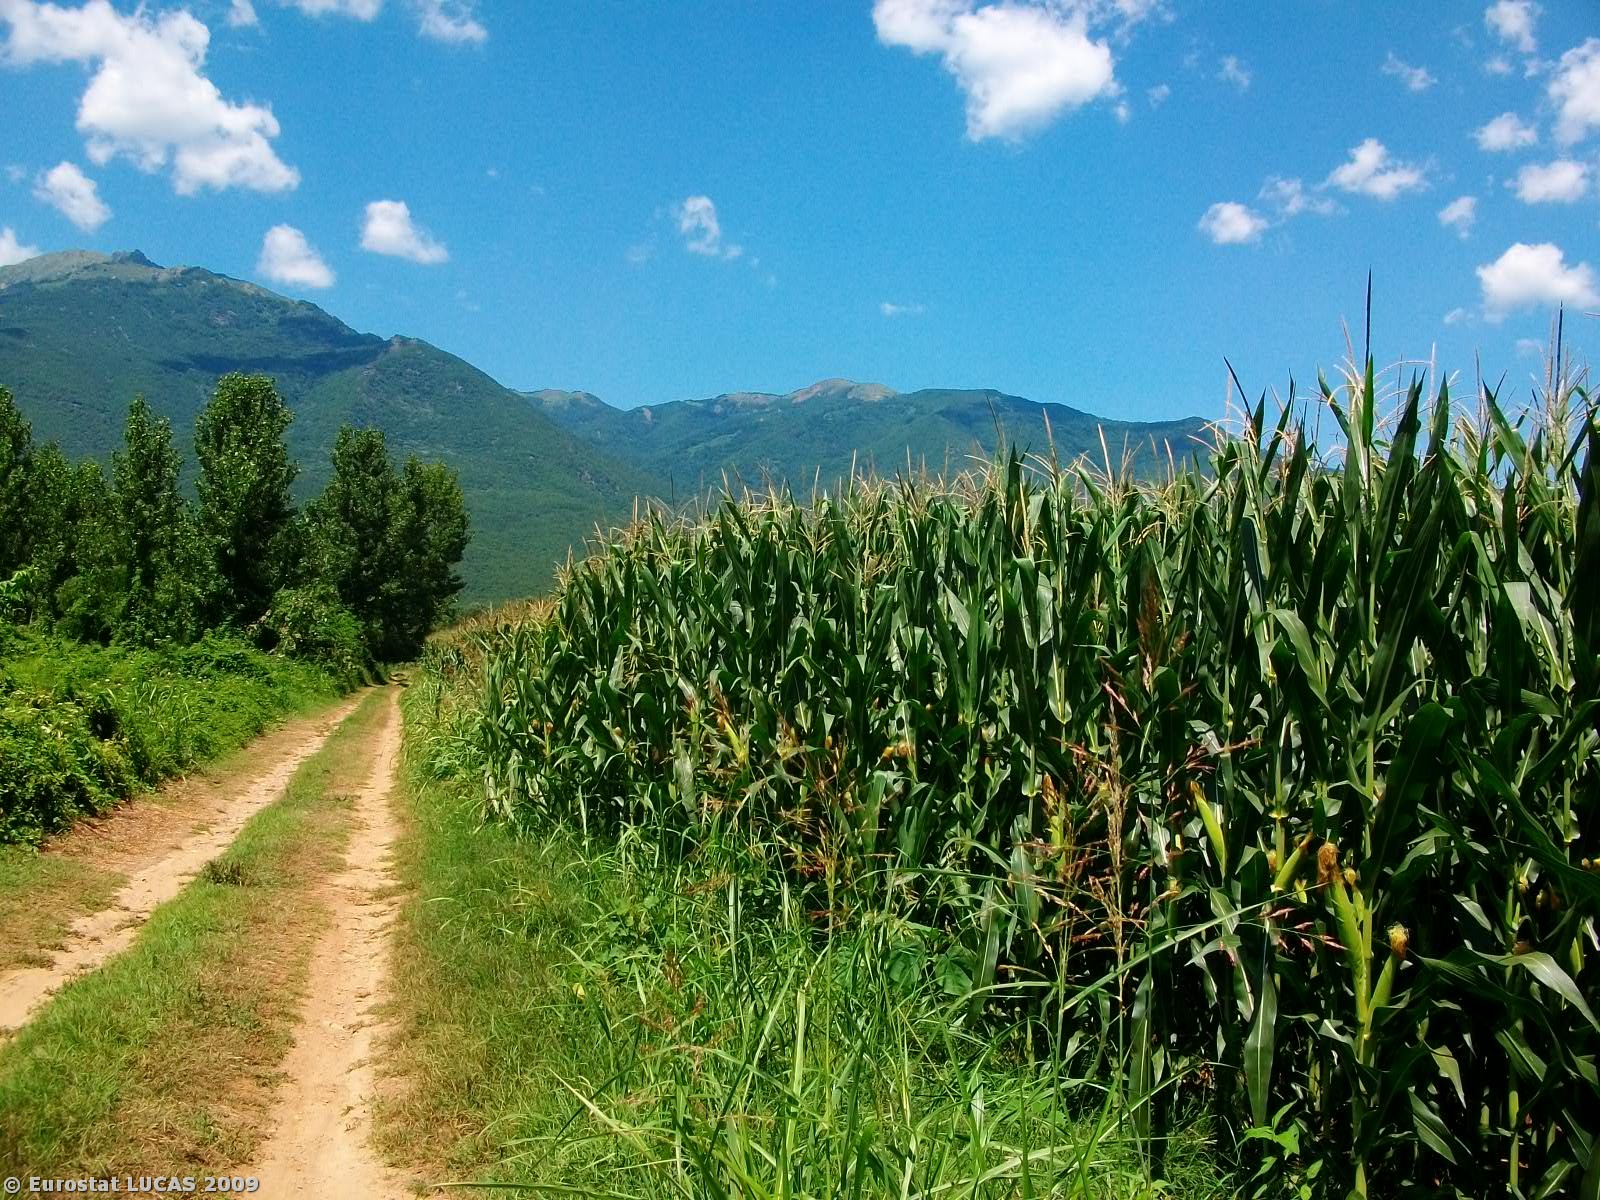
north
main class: Cropland
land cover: Maize
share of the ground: > 75 %
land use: Agriculture (excluding fallow land and kitchen gardens)
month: July
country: GR
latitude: 41.2582
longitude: 23.1817
